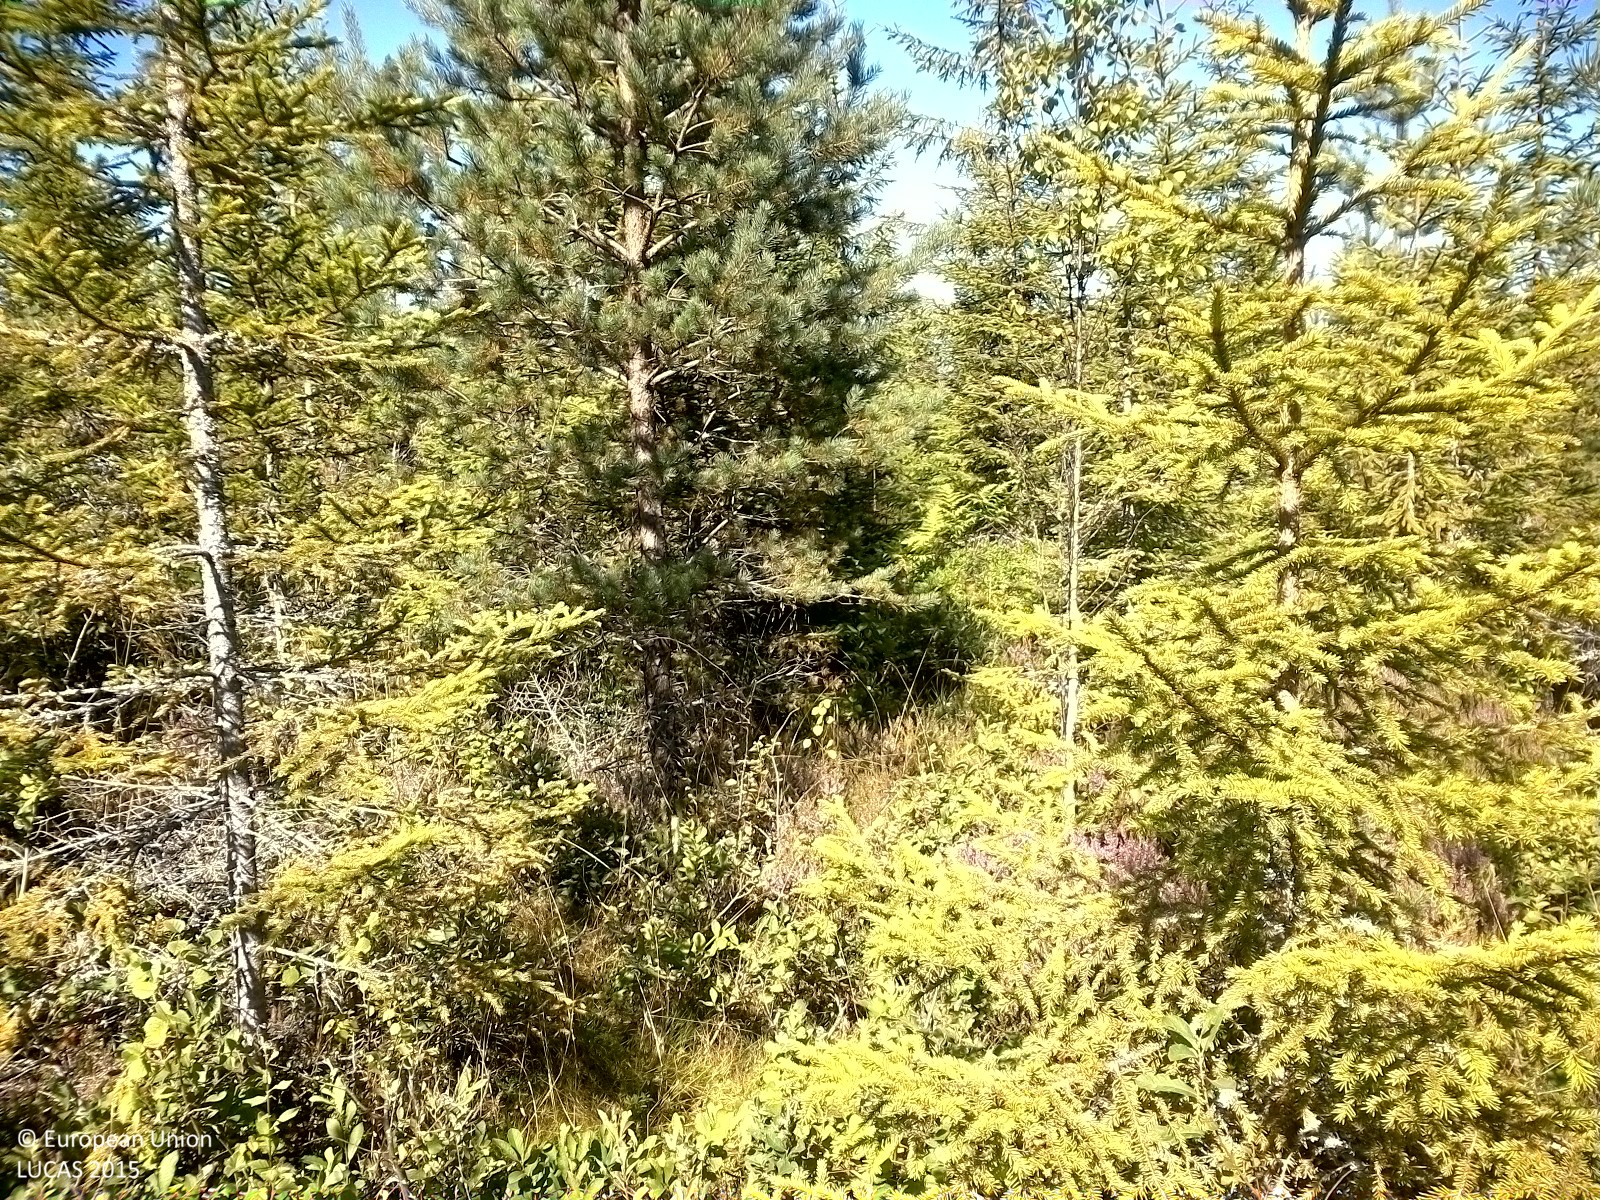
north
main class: Woodland
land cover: Other coniferous woodland
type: boreal forest
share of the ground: 50 - 75 %
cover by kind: coniferous forest trees 60 %, shrubs 25 %, broadleaved forest trees 5 %, herbaceous plants 5 %, lichens and mosses 5 %
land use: Forestry
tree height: < 5 m
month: August
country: SE
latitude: 59.4340
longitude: 14.7335
